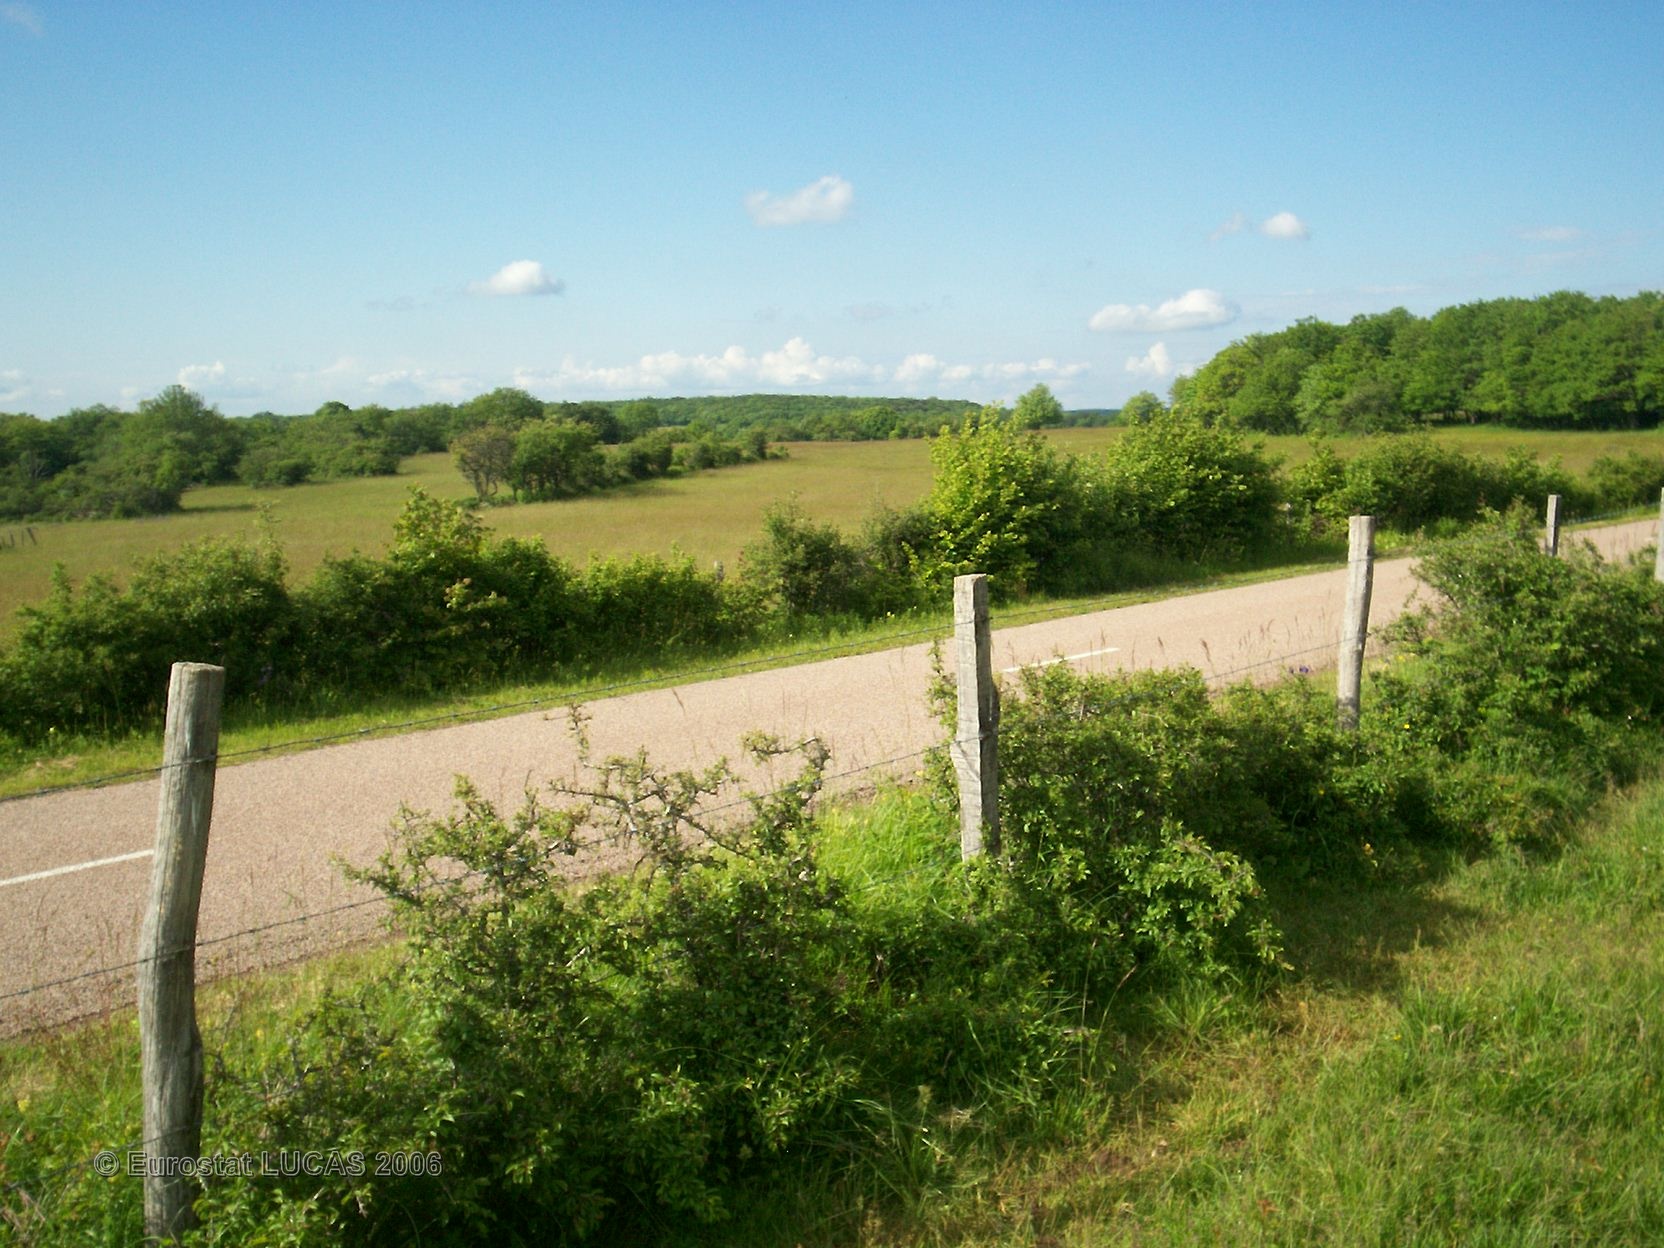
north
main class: Grassland
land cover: Grassland without tree/shrub cover
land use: Agriculture (excluding fallow land and kitchen gardens)
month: June
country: FR
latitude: 47.1241
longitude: 4.7409
